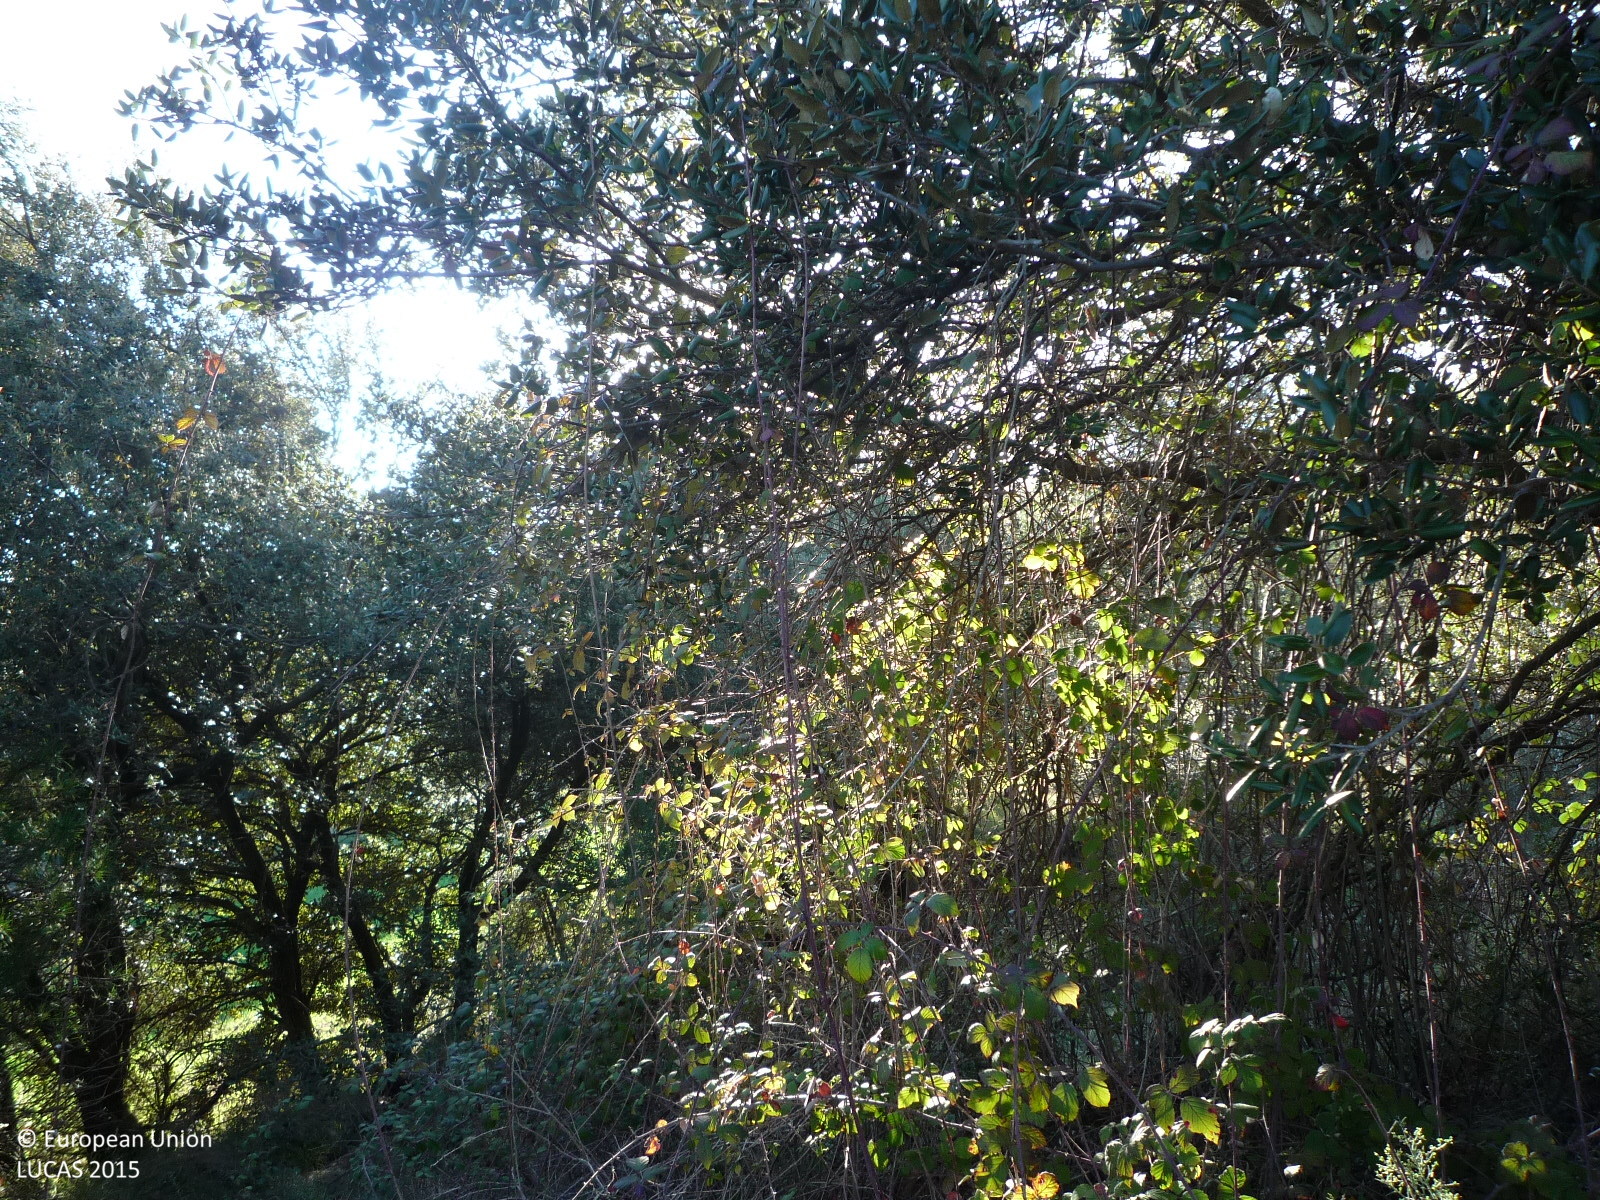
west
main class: Woodland
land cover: Broadleaved woodland
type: broadleaved evergreen forest
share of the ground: > 75 %
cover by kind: broadleaved forest trees 40 %, shrubs 40 %, herbaceous plants 20 %
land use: Semi-natural and natural areas not in use
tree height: < 5 m
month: March
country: ES
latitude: 42.0418
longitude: 1.7134
